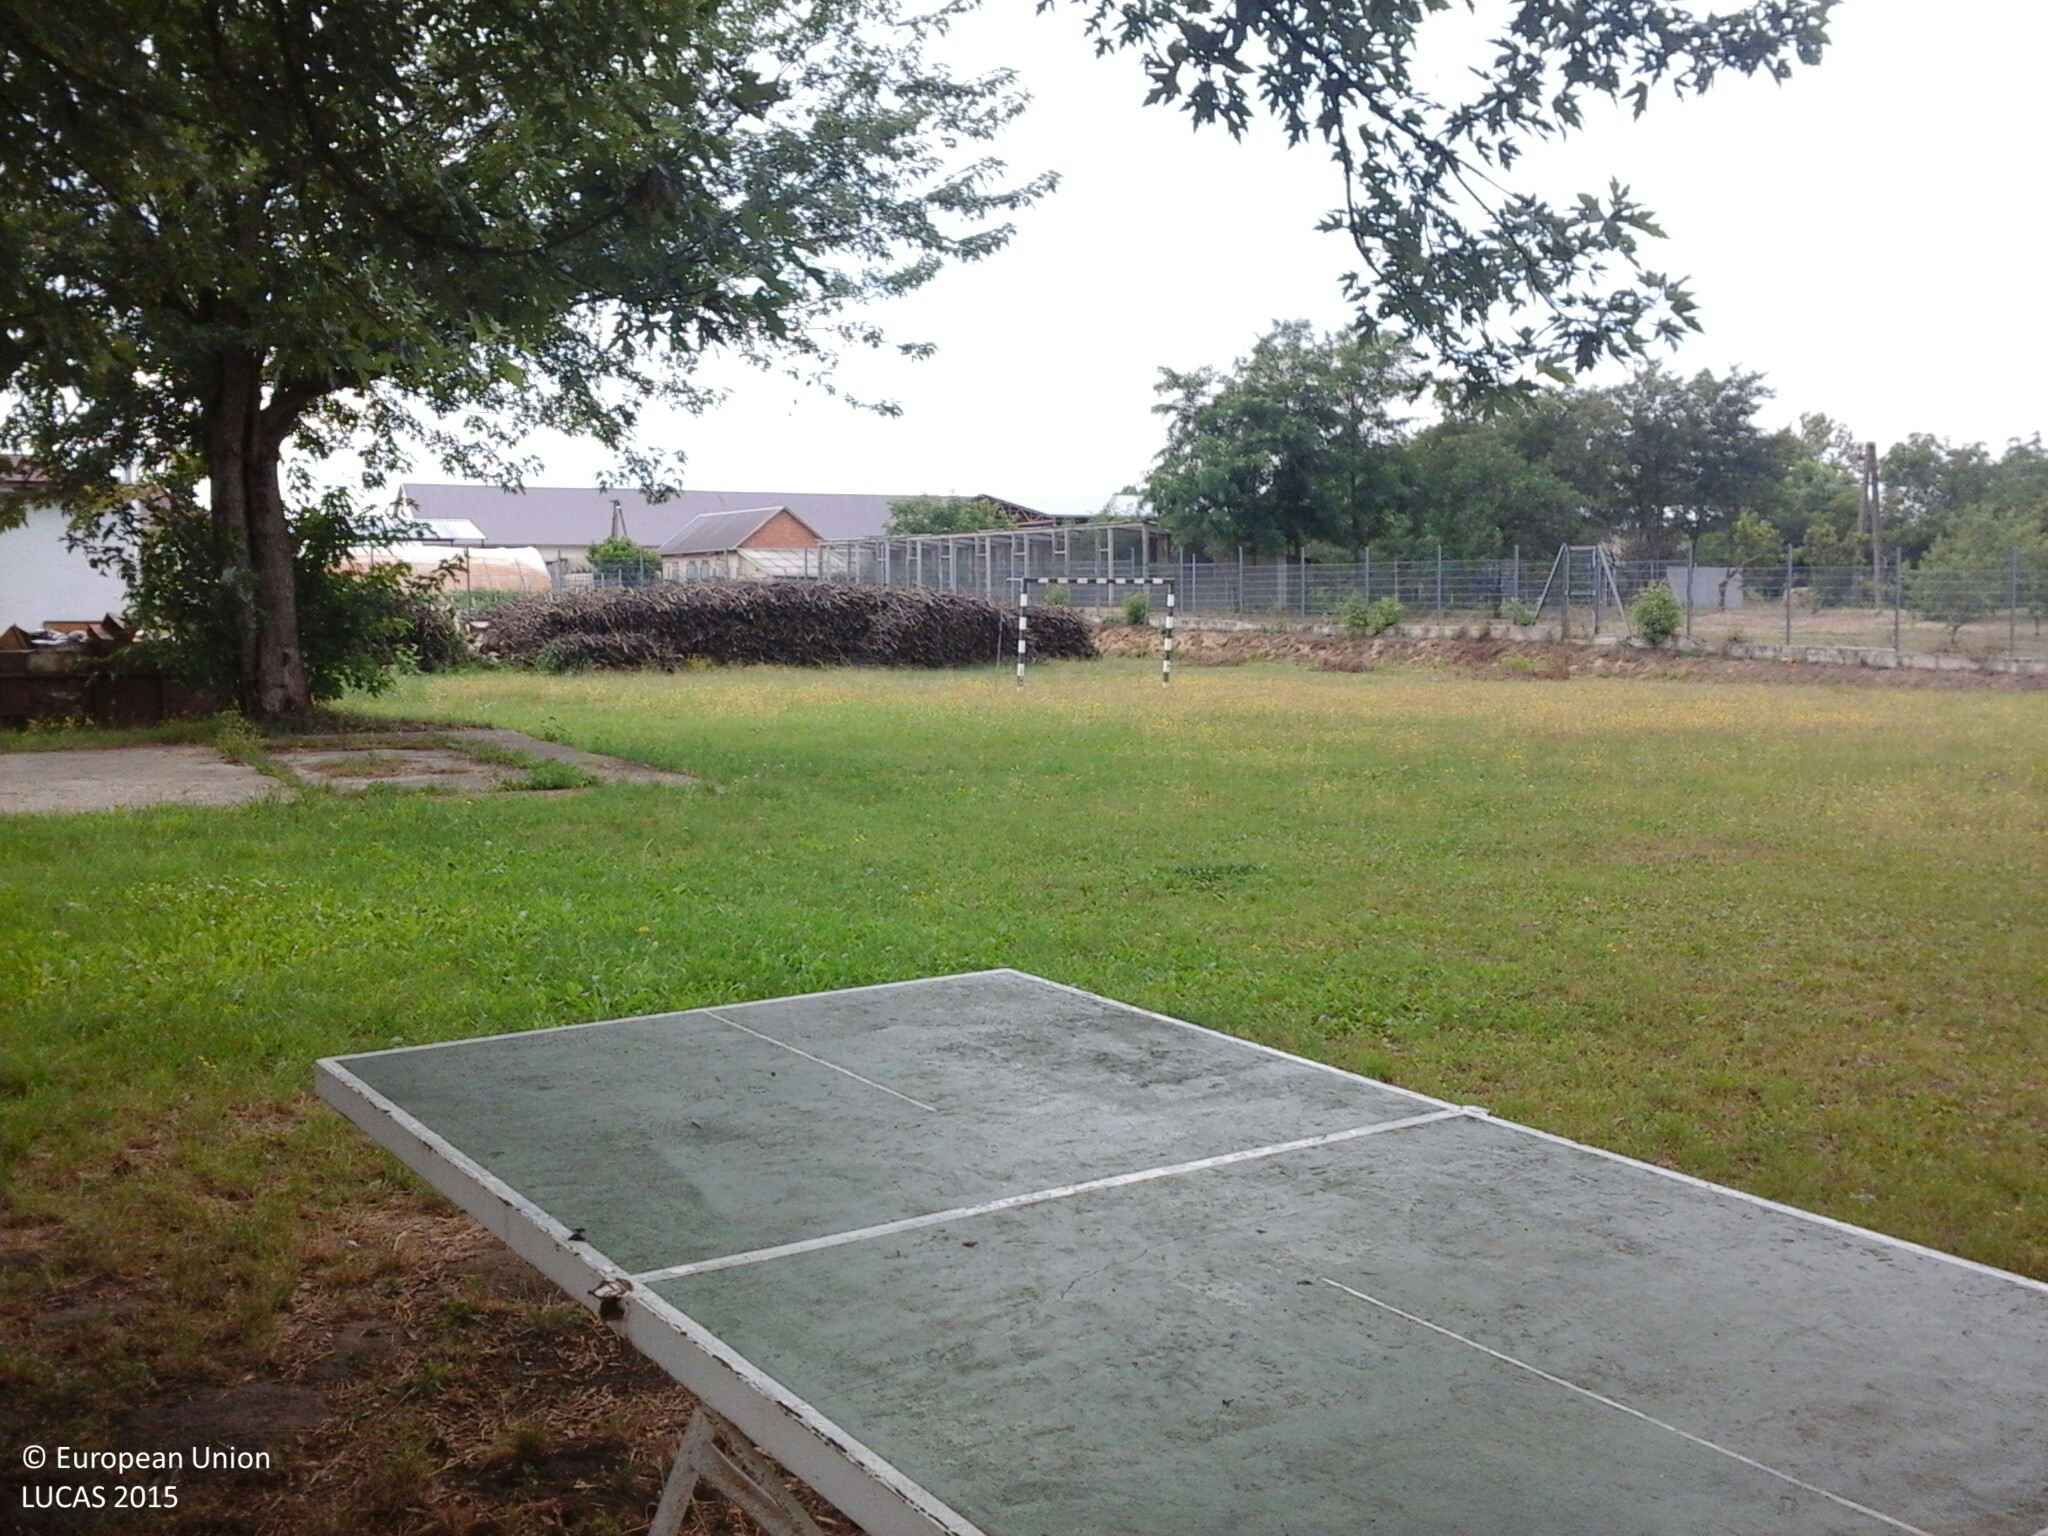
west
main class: Grassland
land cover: Grassland with sparse tree/shrub cover
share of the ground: > 75 %
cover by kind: herbaceous plants 95 %, broadleaved forest trees 5 %
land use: Amenities, museums, leisure
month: July
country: HU
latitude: 48.2005
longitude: 22.1782
